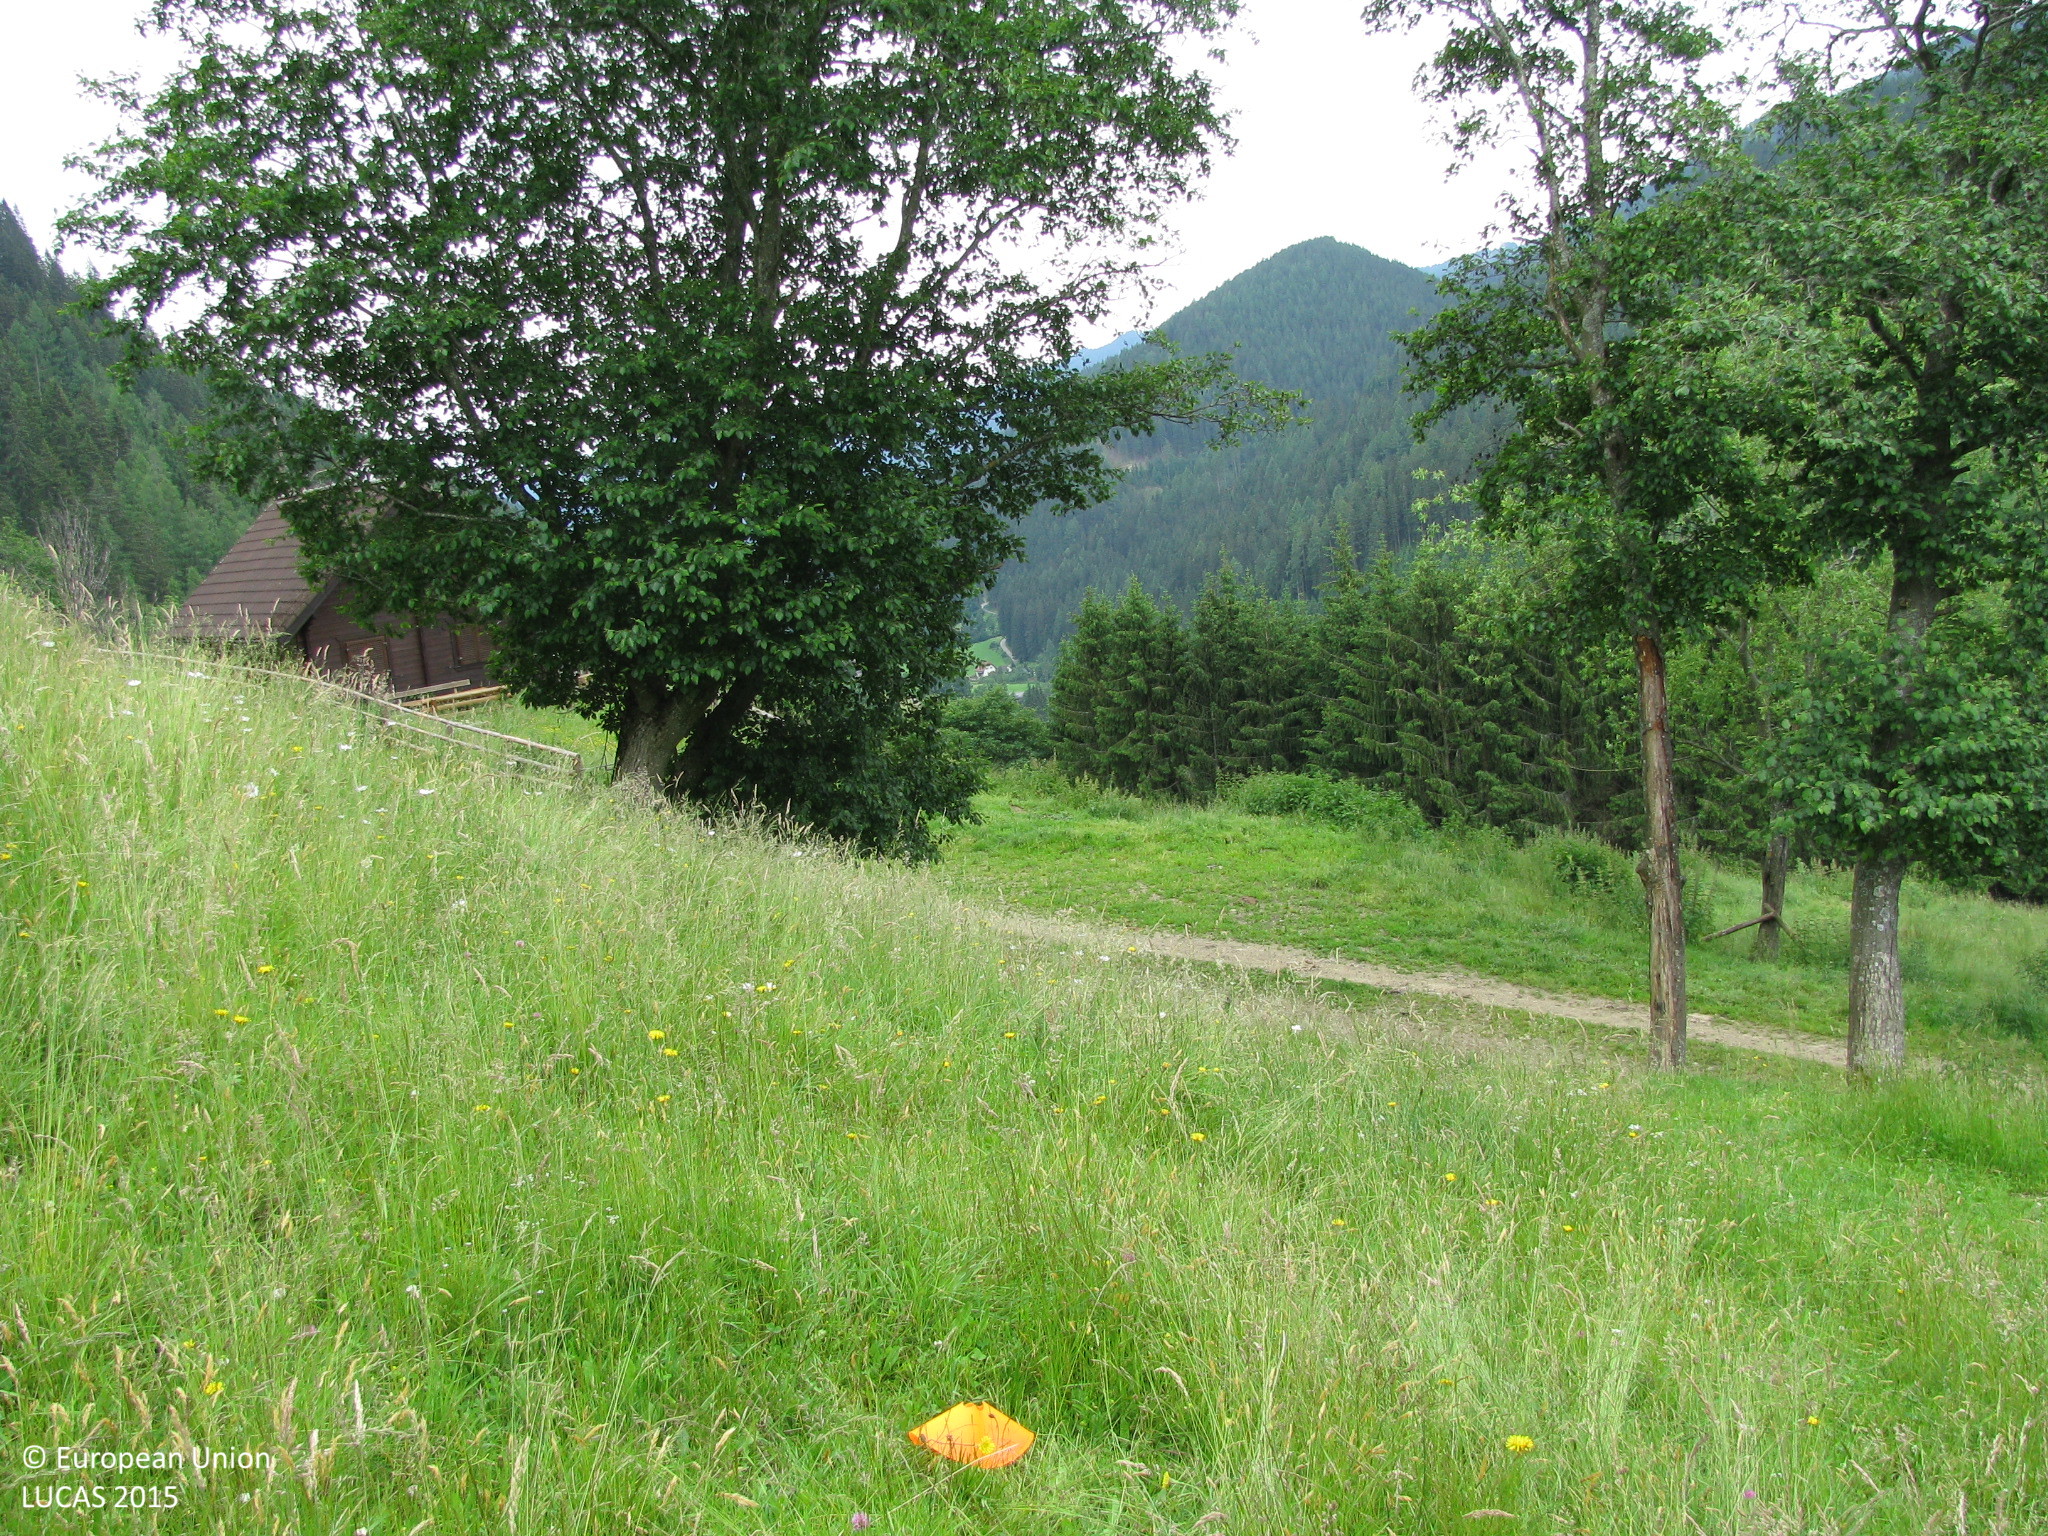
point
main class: Grassland
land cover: Grassland without tree/shrub cover
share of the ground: > 75 %
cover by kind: herbaceous plants 100 %
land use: Agriculture (excluding fallow land and kitchen gardens)
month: June
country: AT
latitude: 47.2786
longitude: 14.6391
